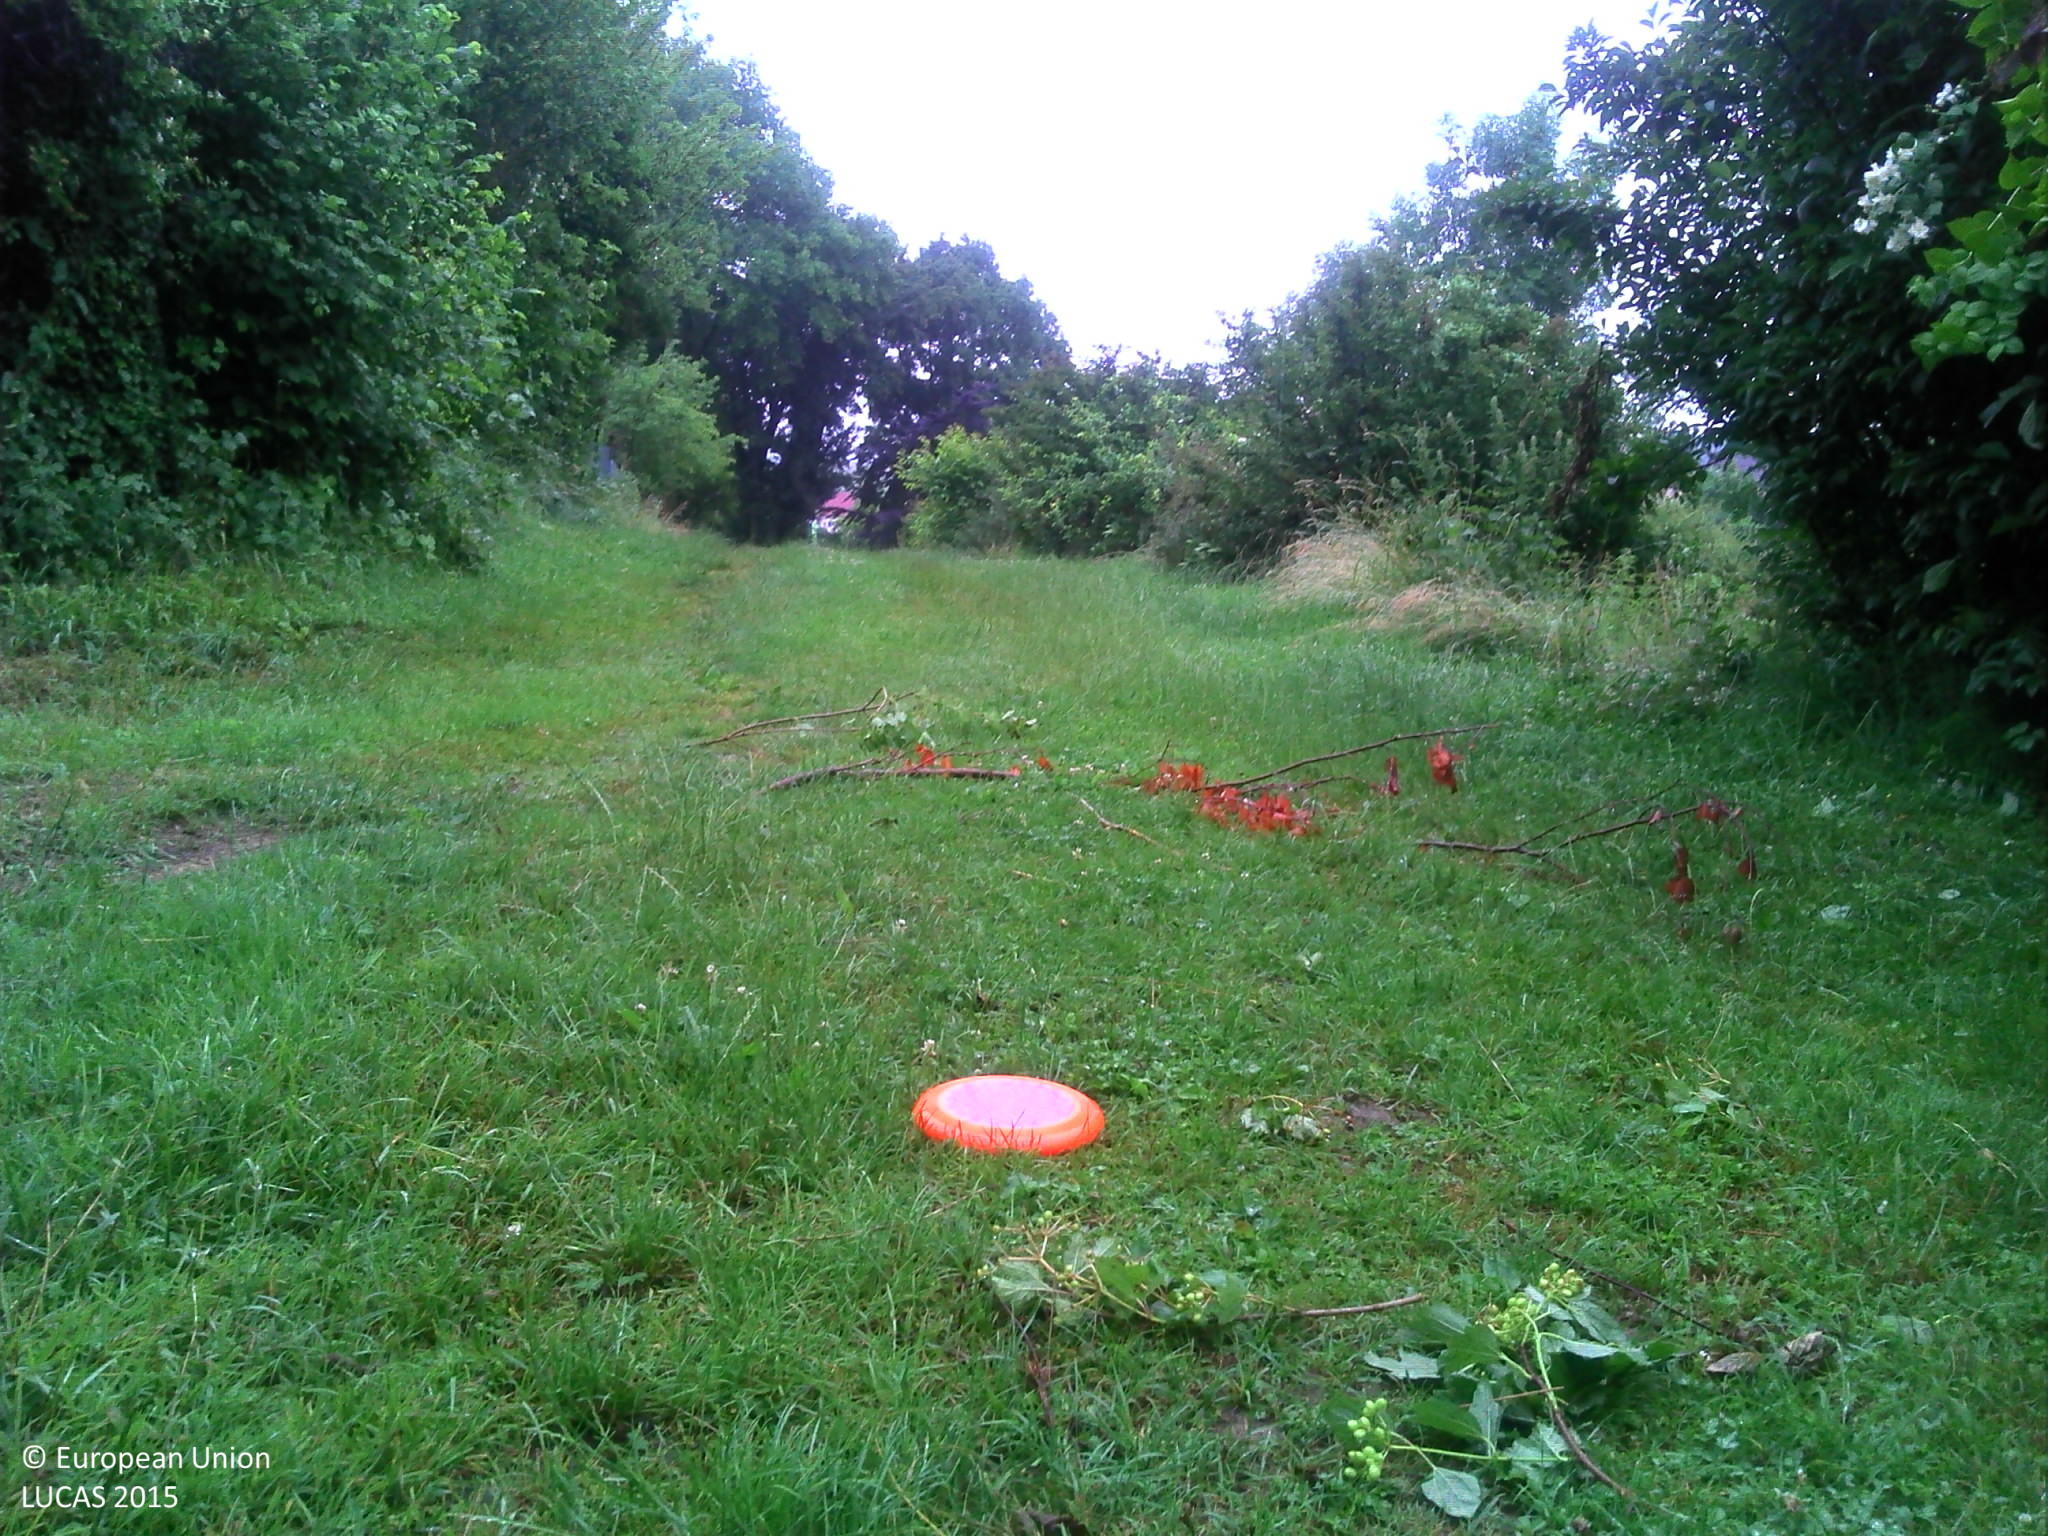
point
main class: Grassland
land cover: Grassland with sparse tree/shrub cover
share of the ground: > 75 %
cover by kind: herbaceous plants 95 %, broadleaved forest trees 5 %
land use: Agriculture (excluding fallow land and kitchen gardens)
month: June
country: FR
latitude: 47.6522
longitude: 7.3788
